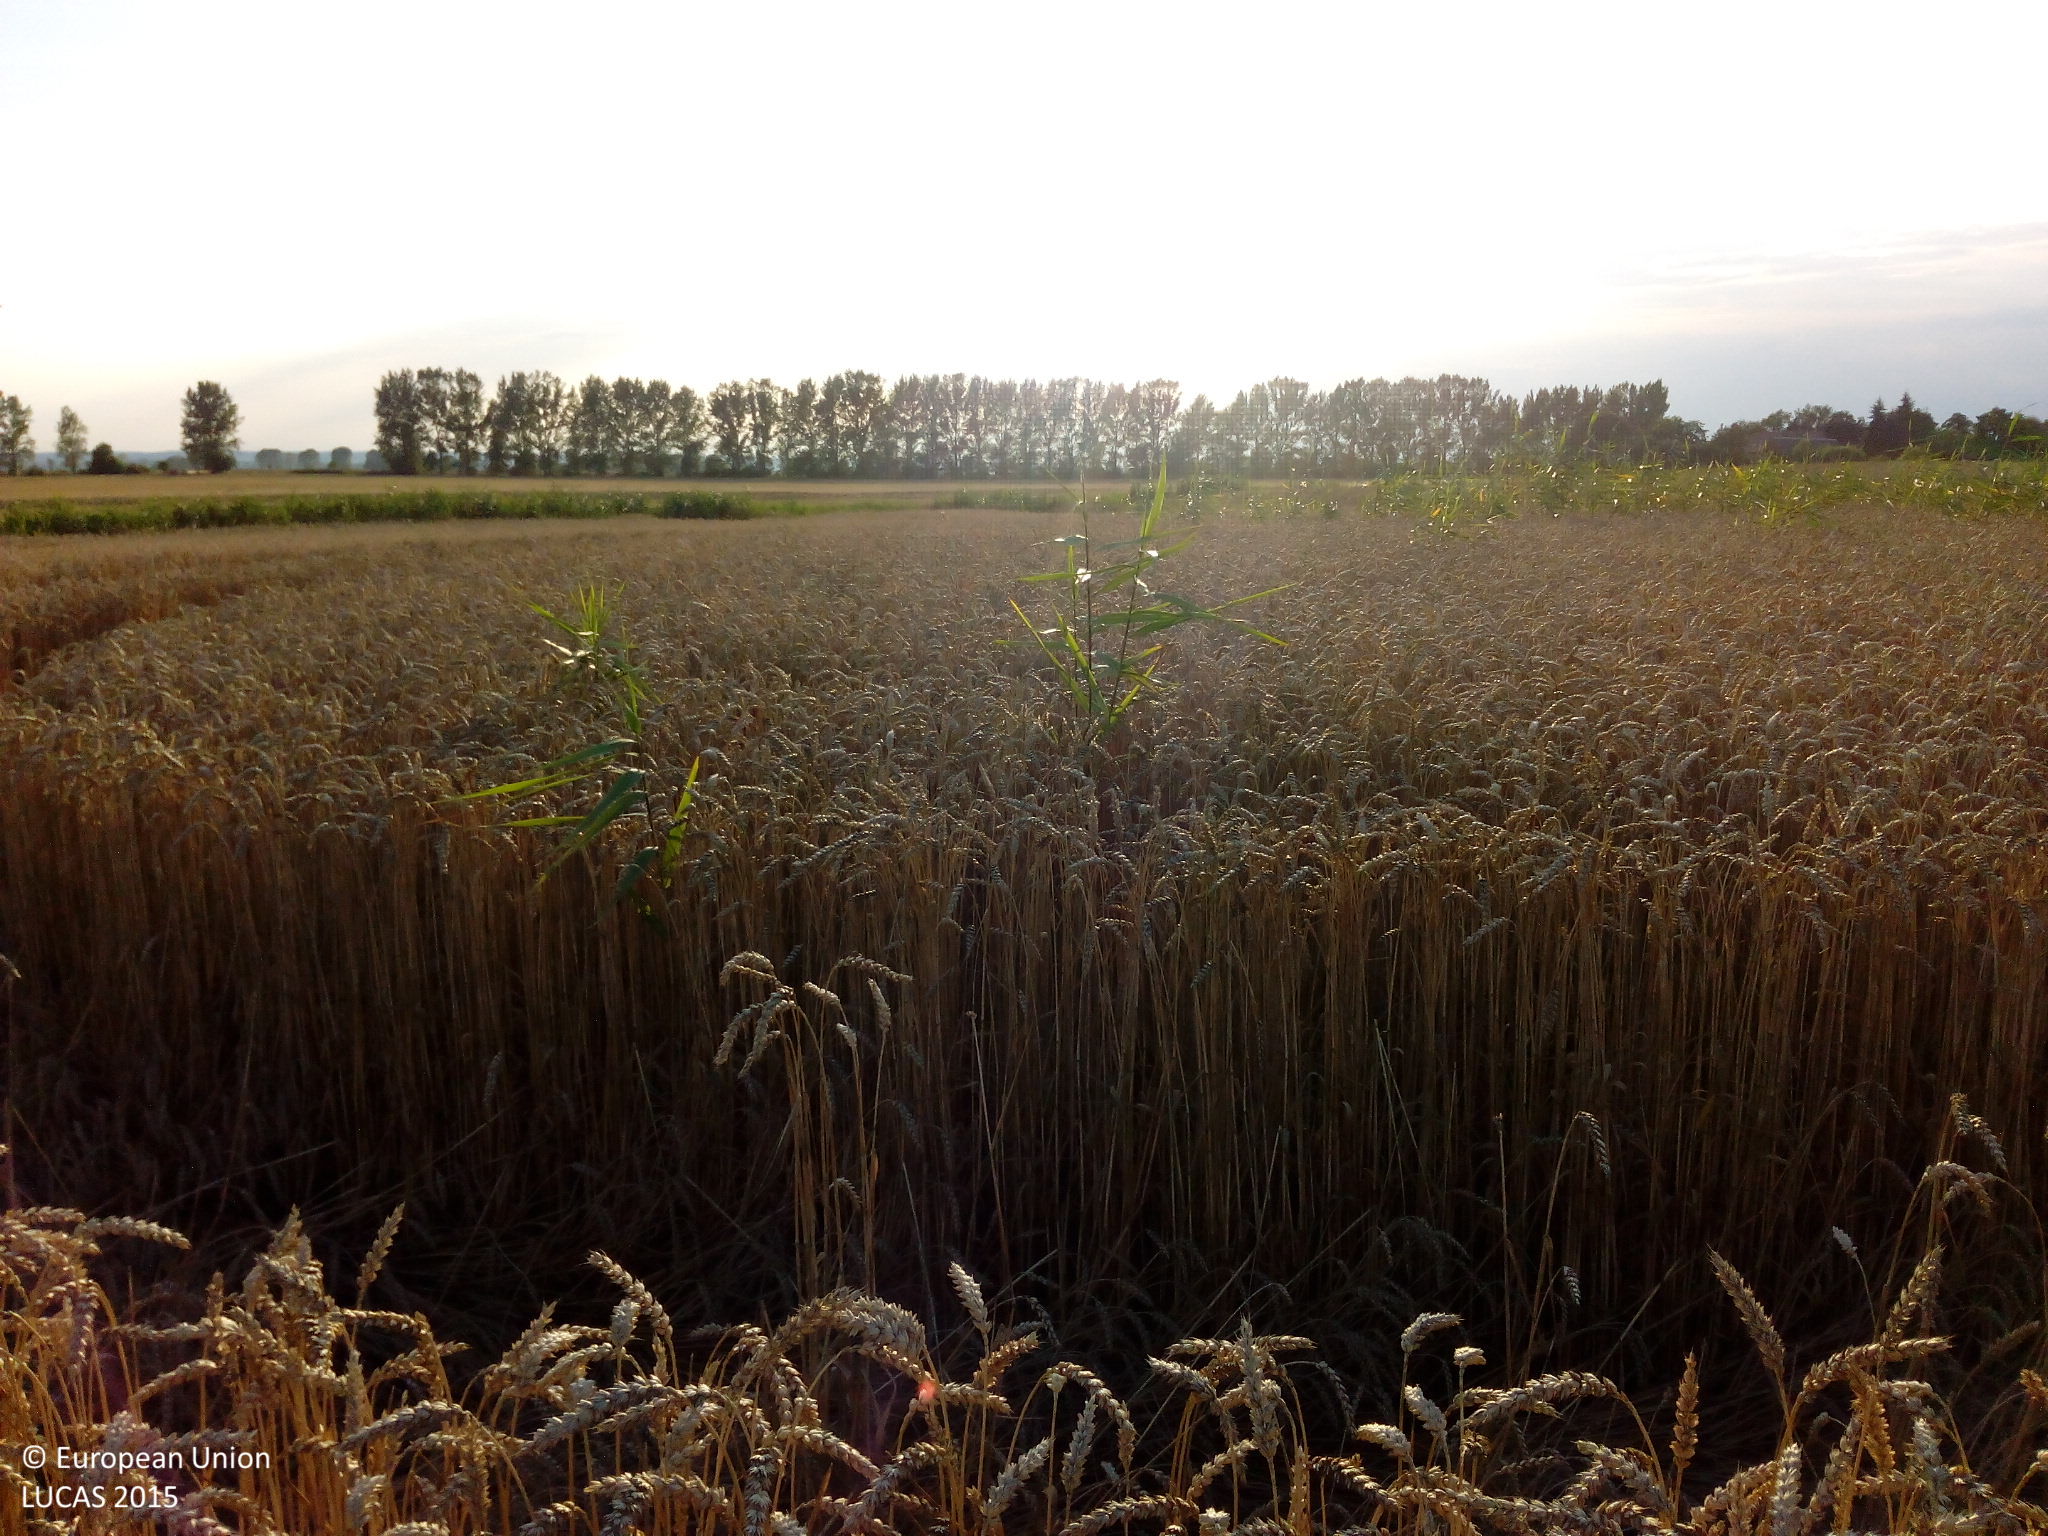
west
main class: Cropland
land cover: Common wheat
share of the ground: > 75 %
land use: Agriculture (excluding fallow land and kitchen gardens)
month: July
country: DE
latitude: 52.7524
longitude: 14.2235
